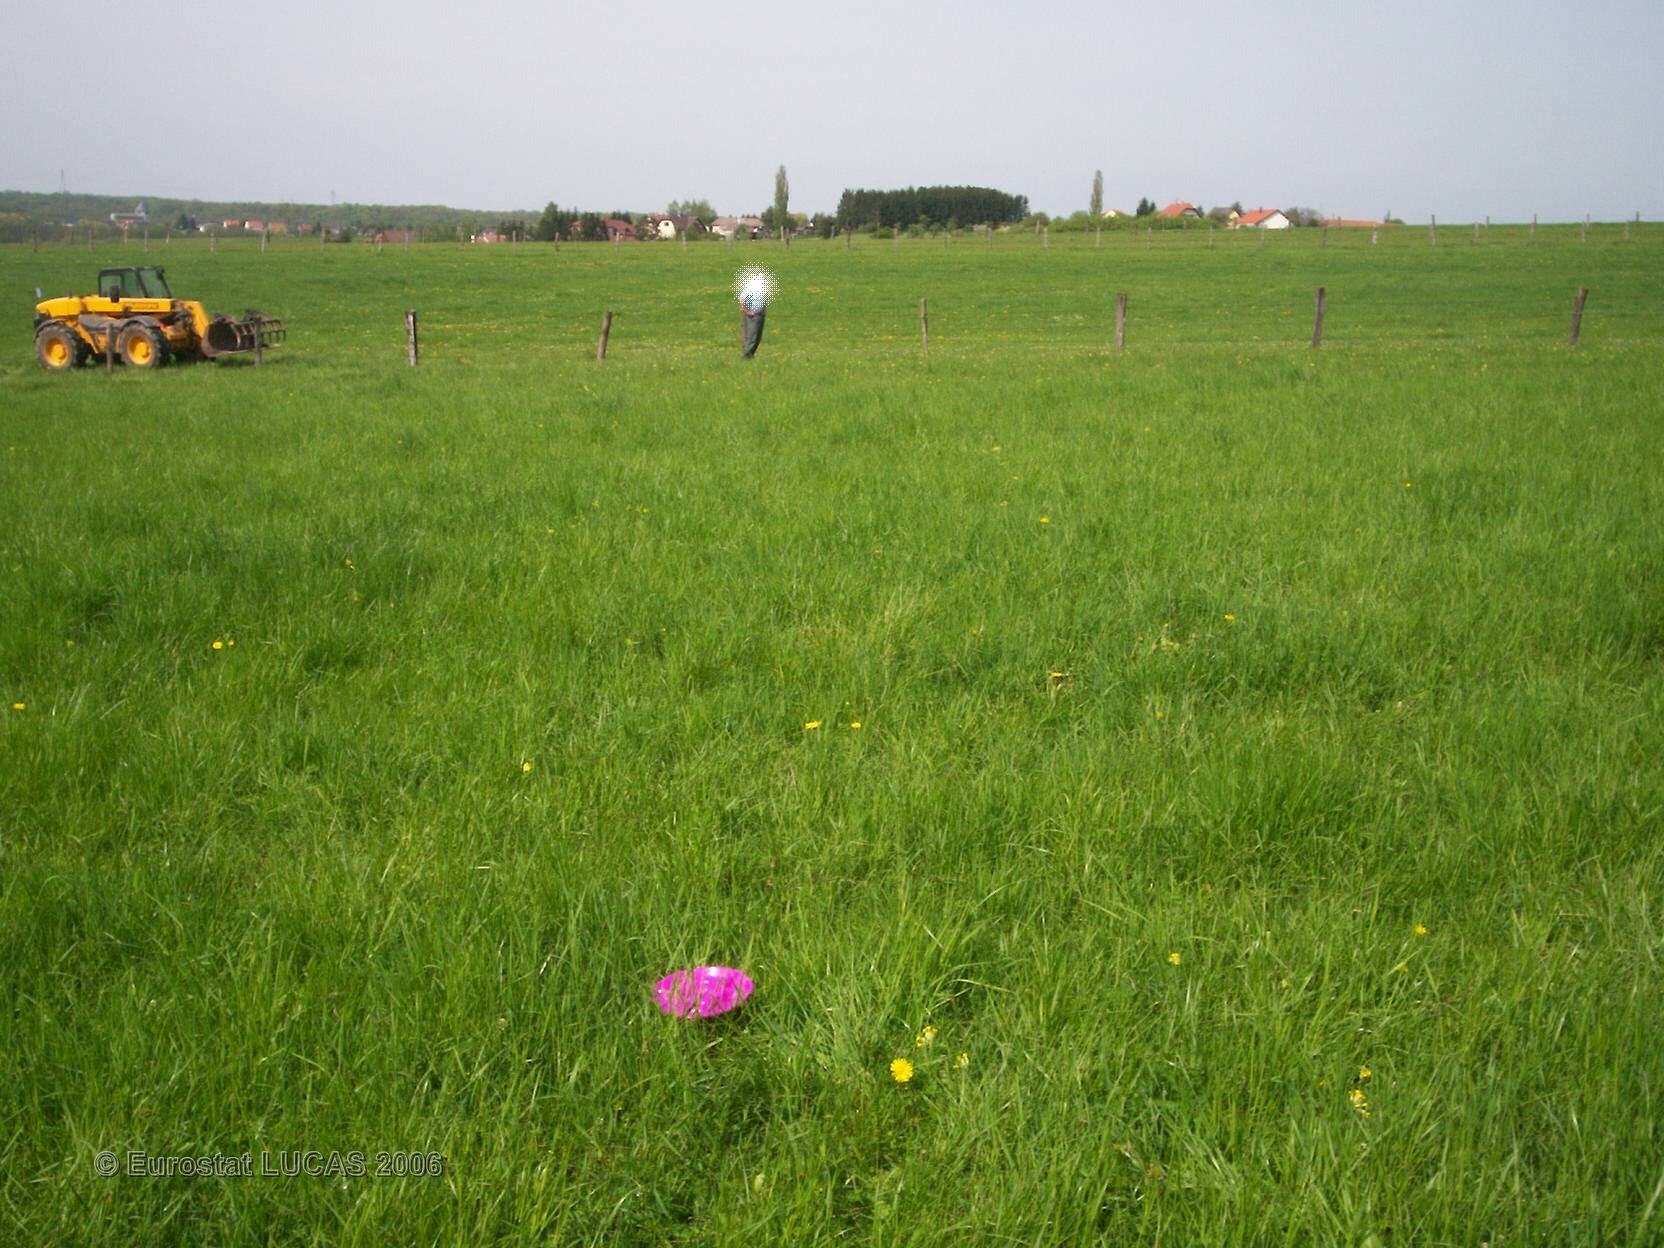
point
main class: Grassland
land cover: Grassland without tree/shrub cover
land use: Agriculture (excluding fallow land and kitchen gardens)
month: May
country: FR
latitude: 49.0665
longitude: 7.0577
